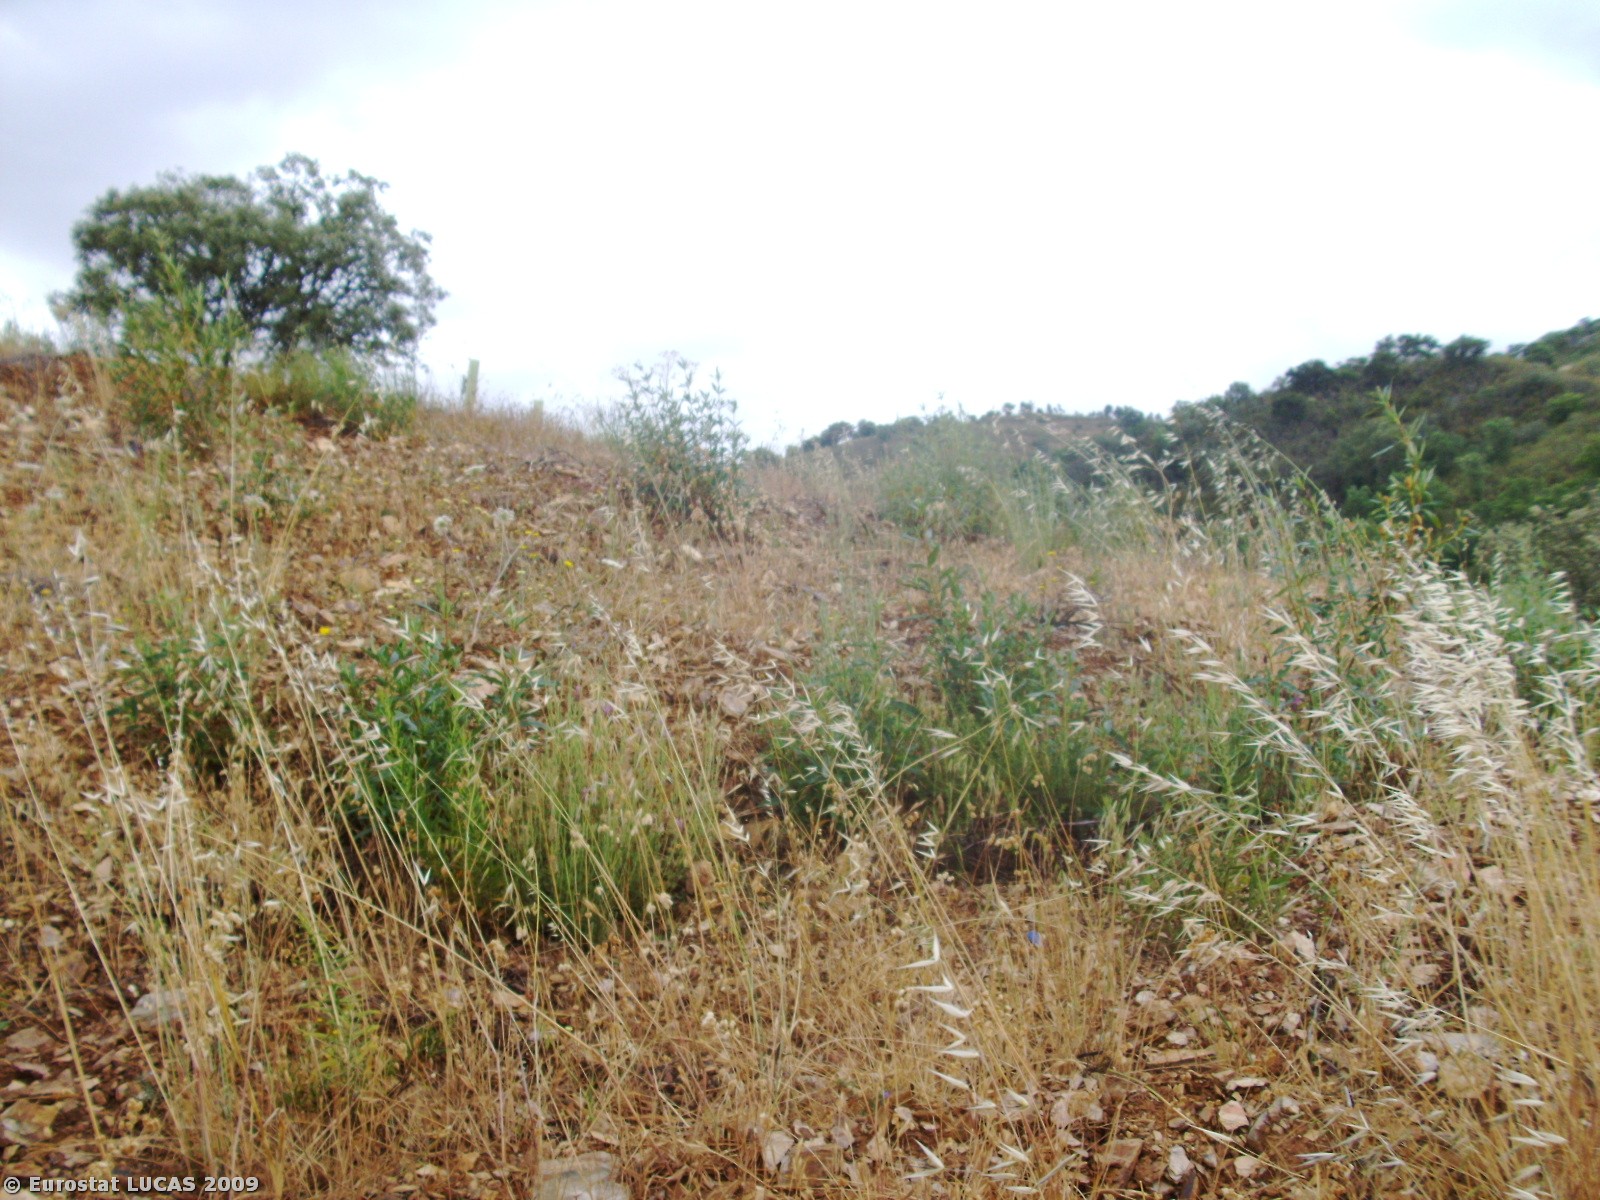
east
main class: Woodland
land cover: Broadleaved woodland
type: broadleaved evergreen forest
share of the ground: 10 - 25 %
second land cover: Spontaneously vegetated surfaces
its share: 50 - 75 %
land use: Forestry
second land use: Fallow land
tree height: > 5 m
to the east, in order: Broadleaved woodland; Spontaneously vegetated surfaces; Other structural elements; Broadleaved woodland; Rivers and streams; Broadleaved woodland; Shrubland with sparse tree cover; Rivers and streams; Shrubland with sparse tree cover; Tracks; Shrubland with sparse tree cover
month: June
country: PT
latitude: 37.4595
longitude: -8.4700
